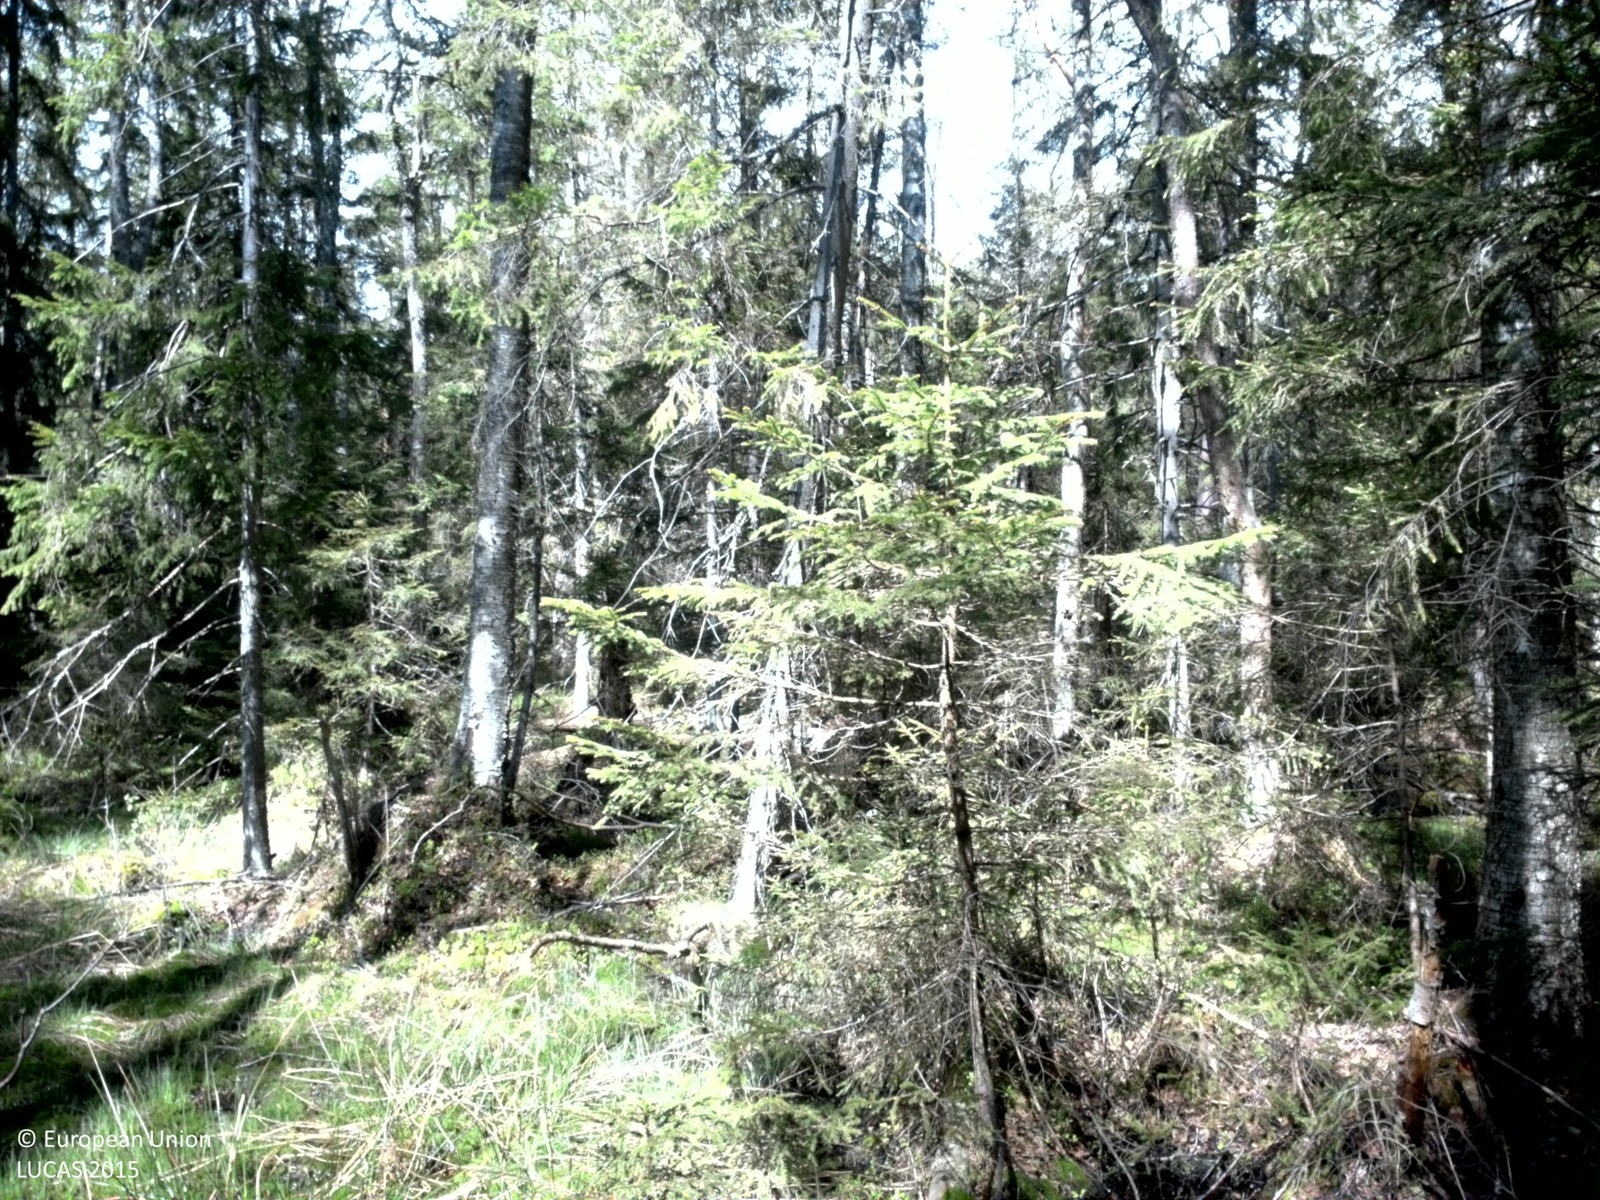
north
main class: Woodland
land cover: Spruce dominated mixed woodland
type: boreal forest
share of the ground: > 75 %
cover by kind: broadleaved forest trees 50 %, coniferous forest trees 40 %, lichens and mosses 10 %
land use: Forestry
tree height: > 5 m
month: May
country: SE
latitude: 56.7319
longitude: 15.1794
